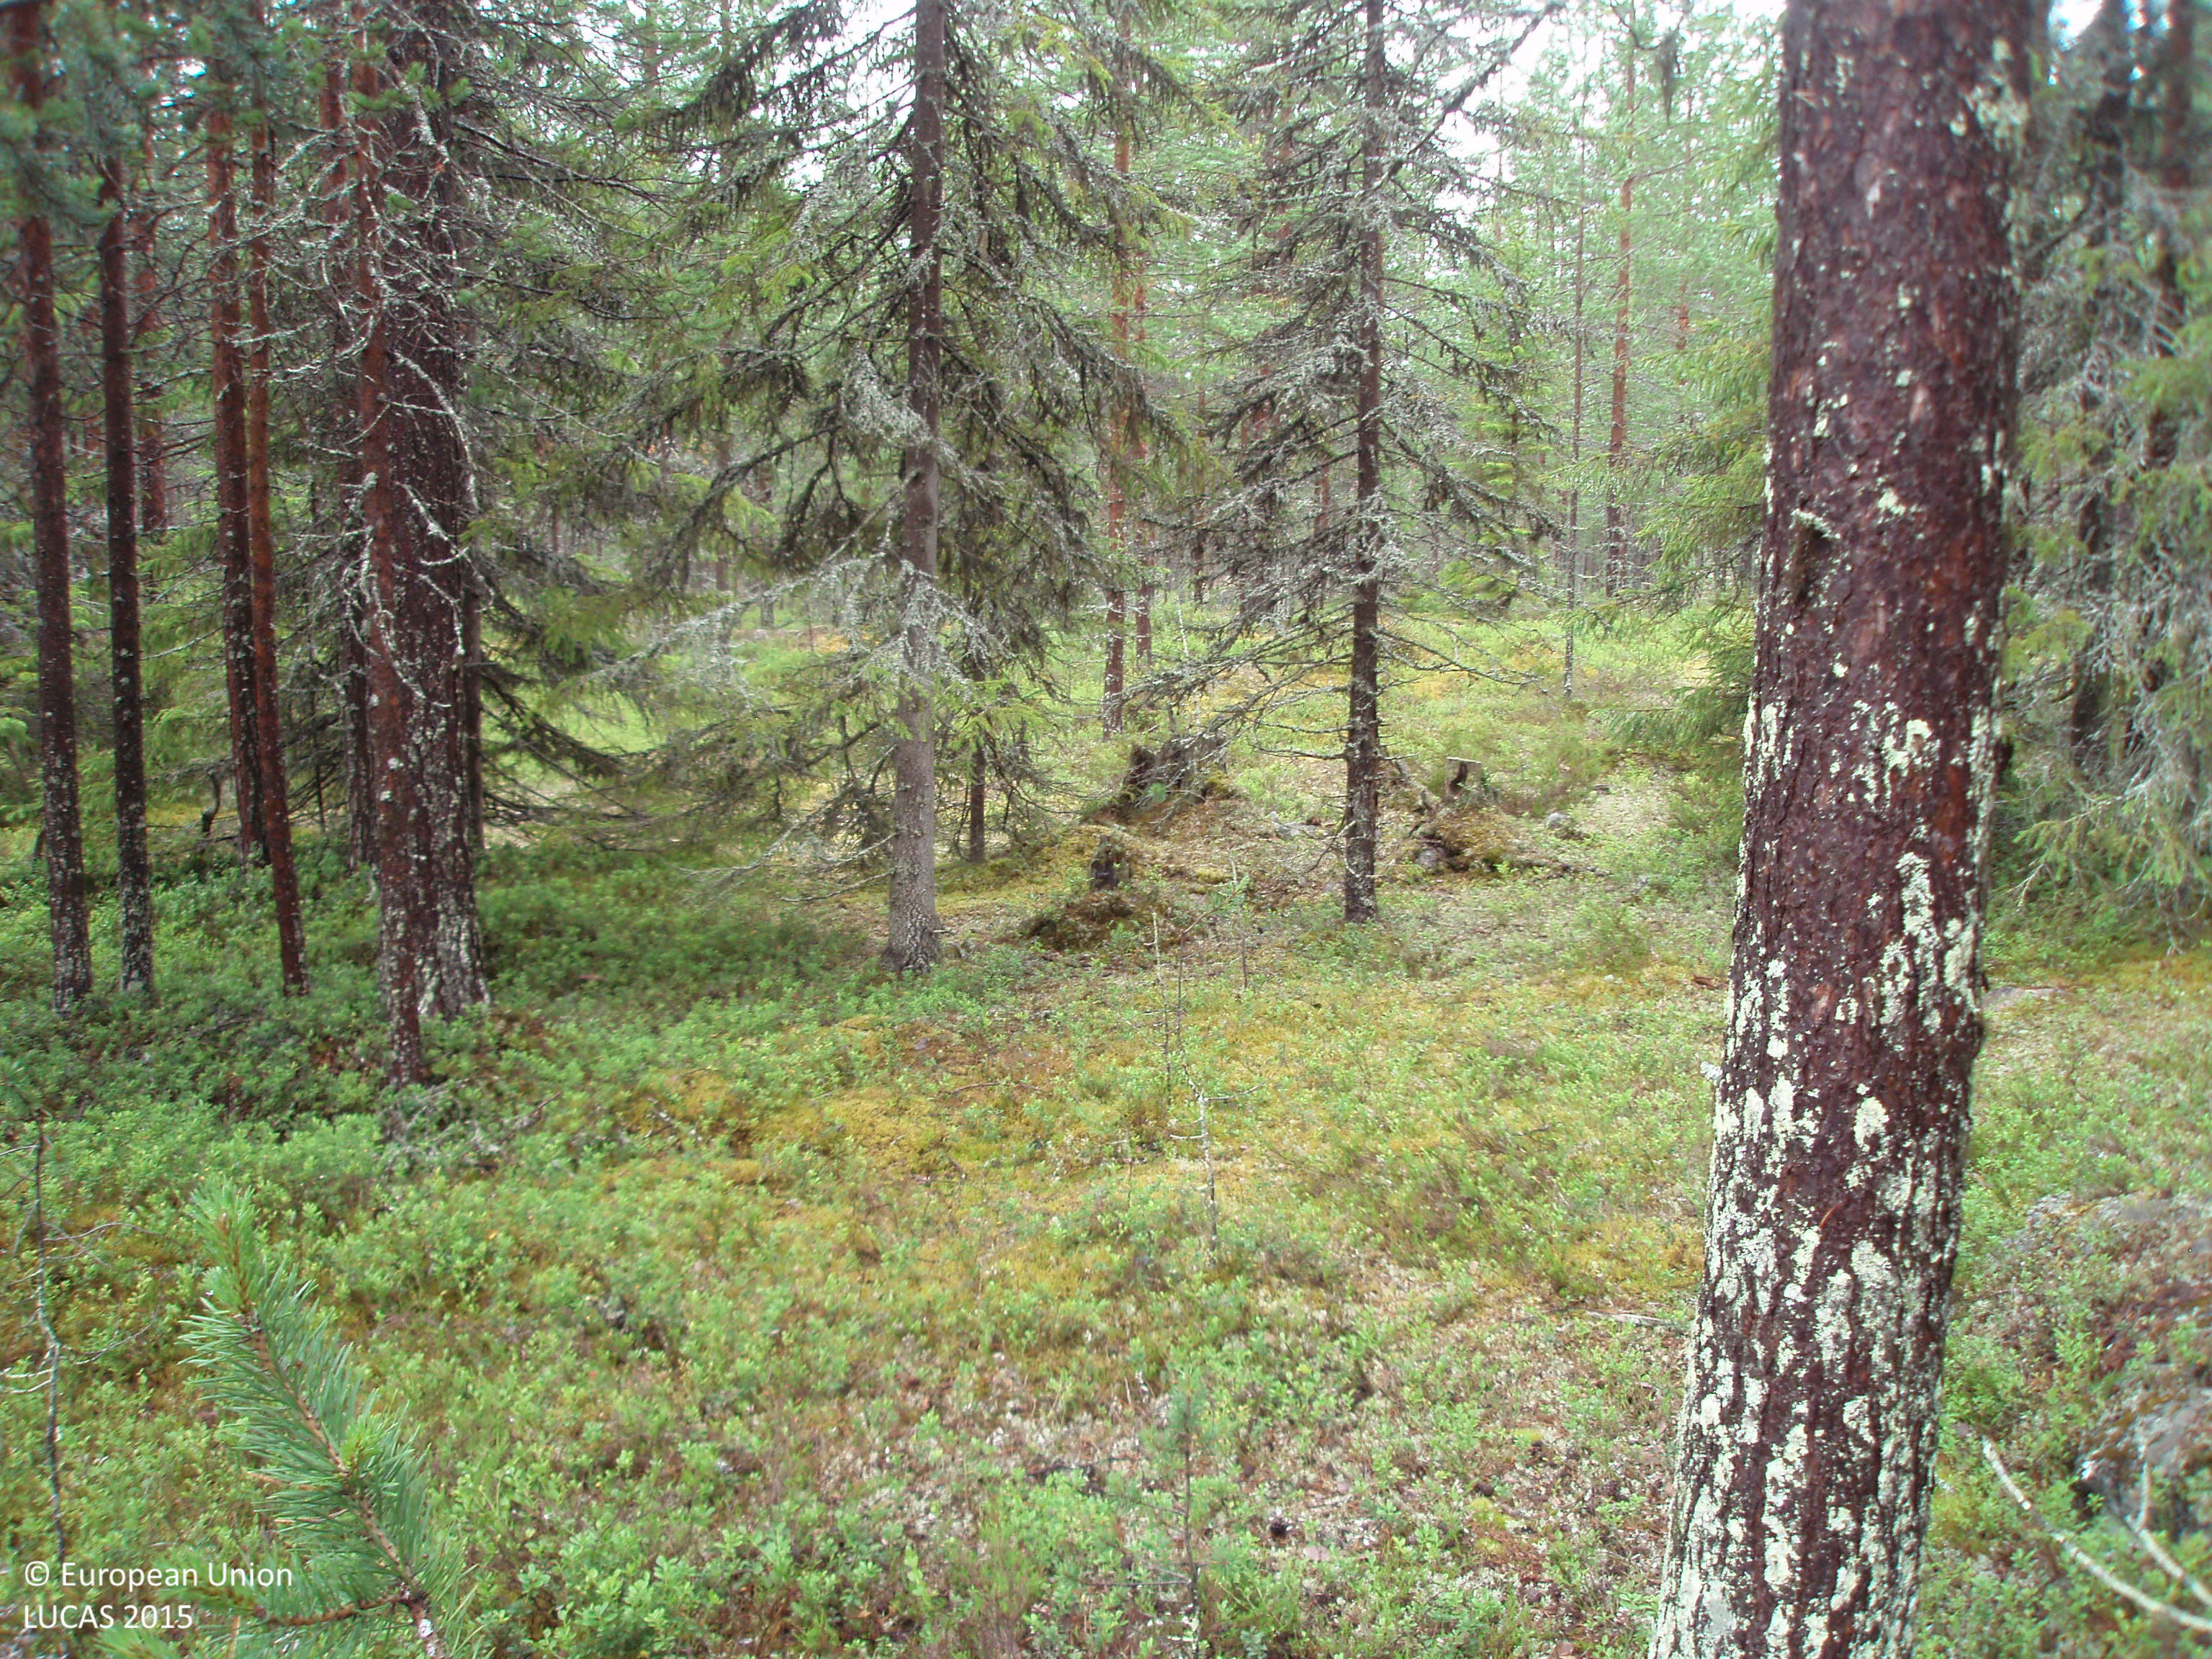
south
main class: Woodland
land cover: Pine dominated coniferous woodland
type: boreal forest
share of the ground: 50 - 75 %
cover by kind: coniferous forest trees 70 %, shrubs 30 %
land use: Forestry
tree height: > 5 m
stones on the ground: 25 - 50 %
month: July
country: FI
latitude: 66.0339
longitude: 28.0762
